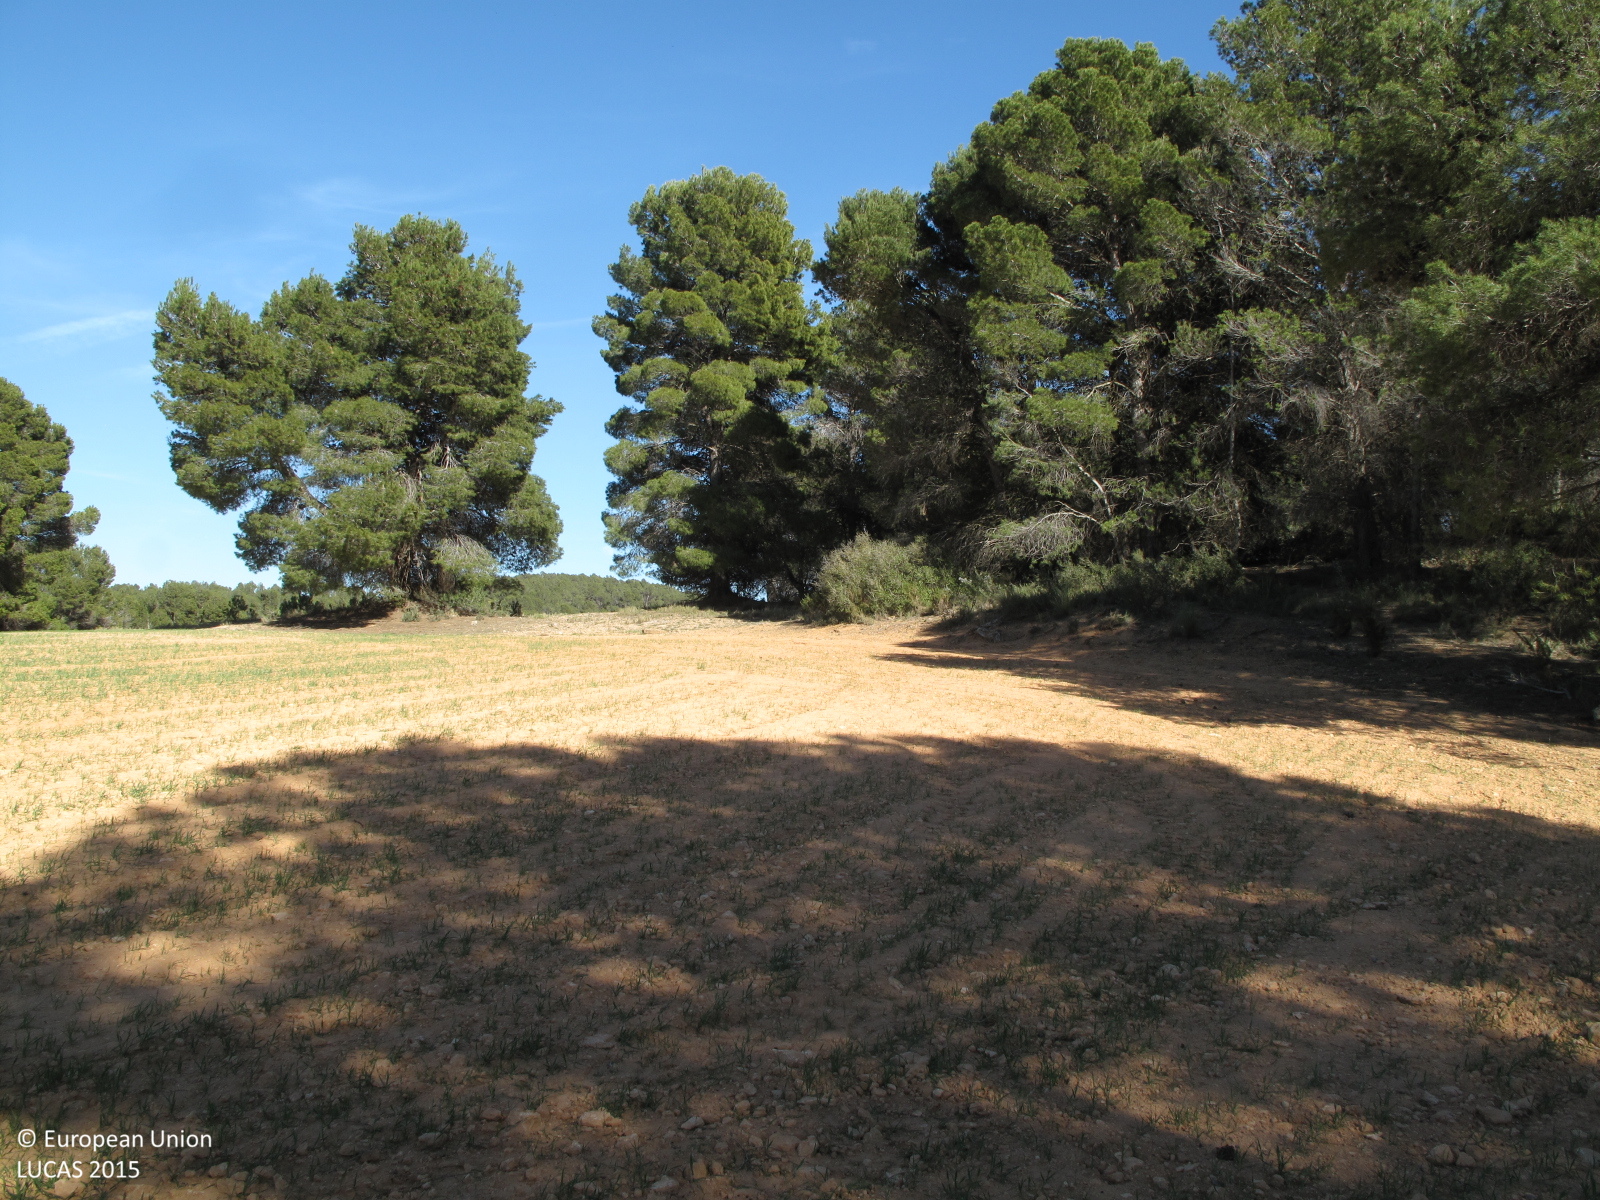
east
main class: Cropland
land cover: Barley
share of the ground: 10 - 25 %
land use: Agriculture (excluding fallow land and kitchen gardens)
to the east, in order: Barley; Other bare soil; Pine dominated coniferous woodland; Tracks; Pine dominated coniferous woodland; Spontaneously vegetated surfaces; Shrubland with sparse tree cover; Other bare soil; Spontaneously vegetated surfaces; Pine dominated coniferous woodland
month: March
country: ES
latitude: 38.8262
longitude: -0.9933
